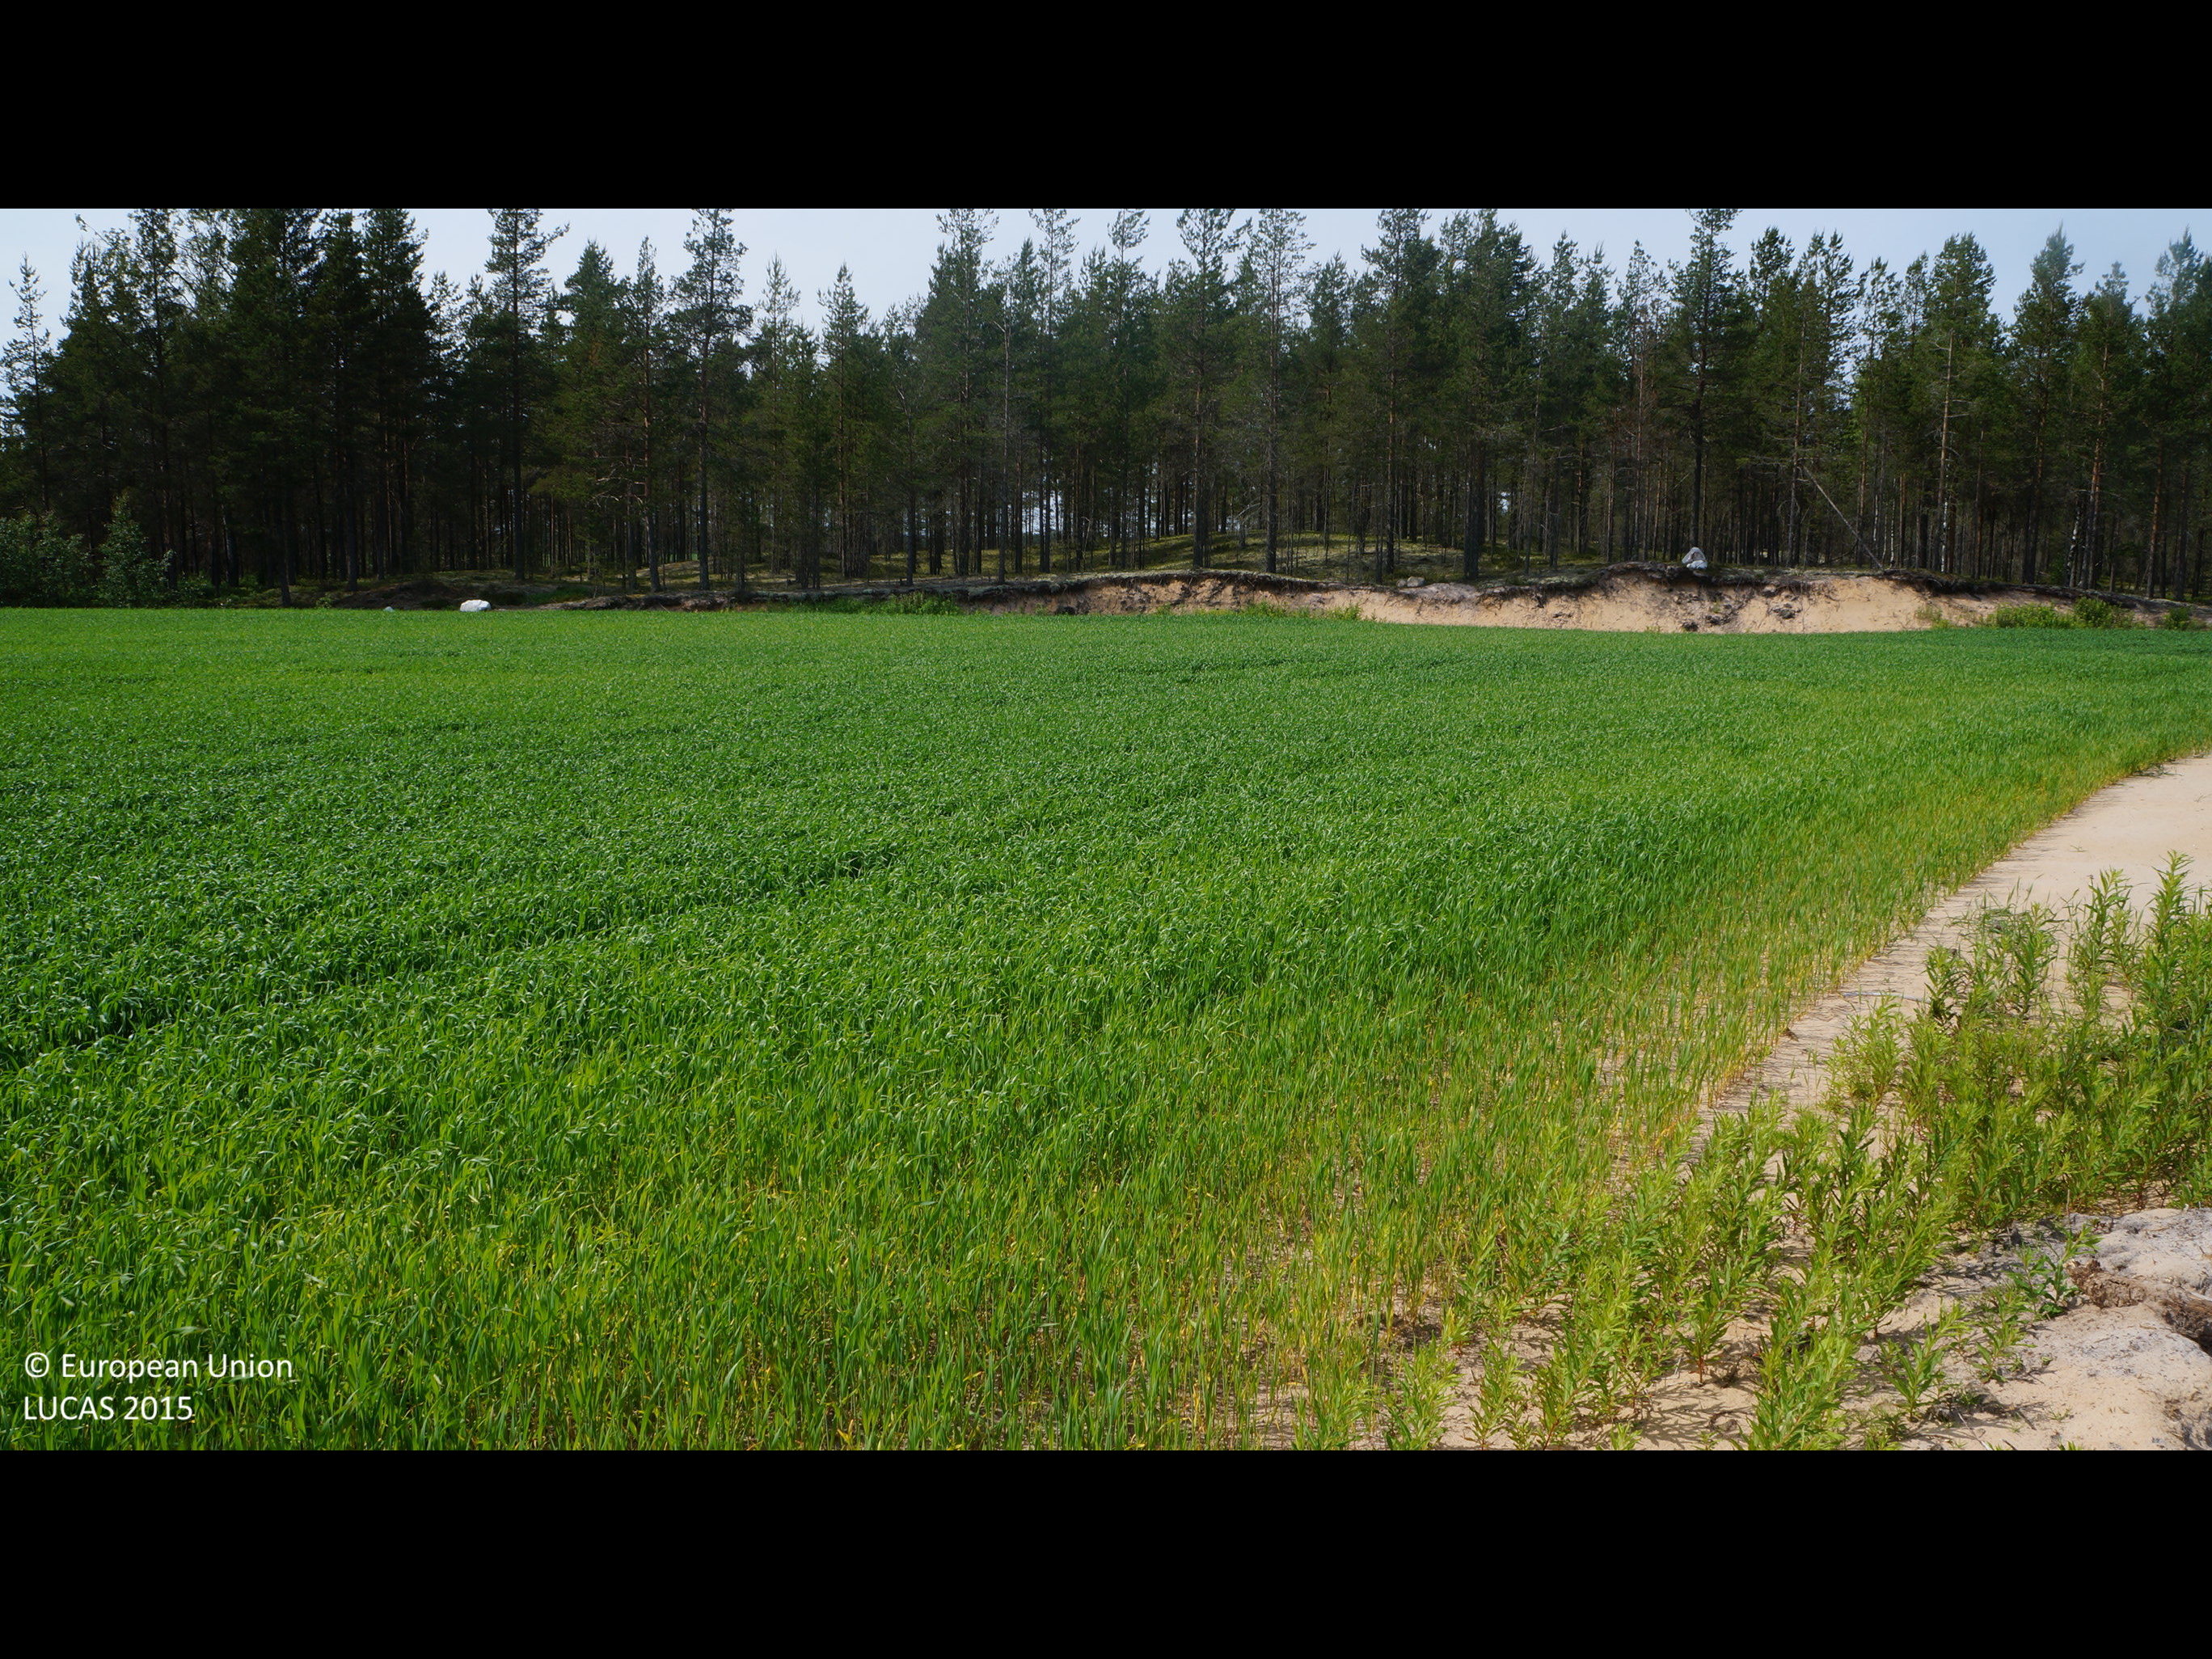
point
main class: Cropland
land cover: Common wheat
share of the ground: > 75 %
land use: Agriculture (excluding fallow land and kitchen gardens)
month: June
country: FI
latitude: 64.1508
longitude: 23.8967
